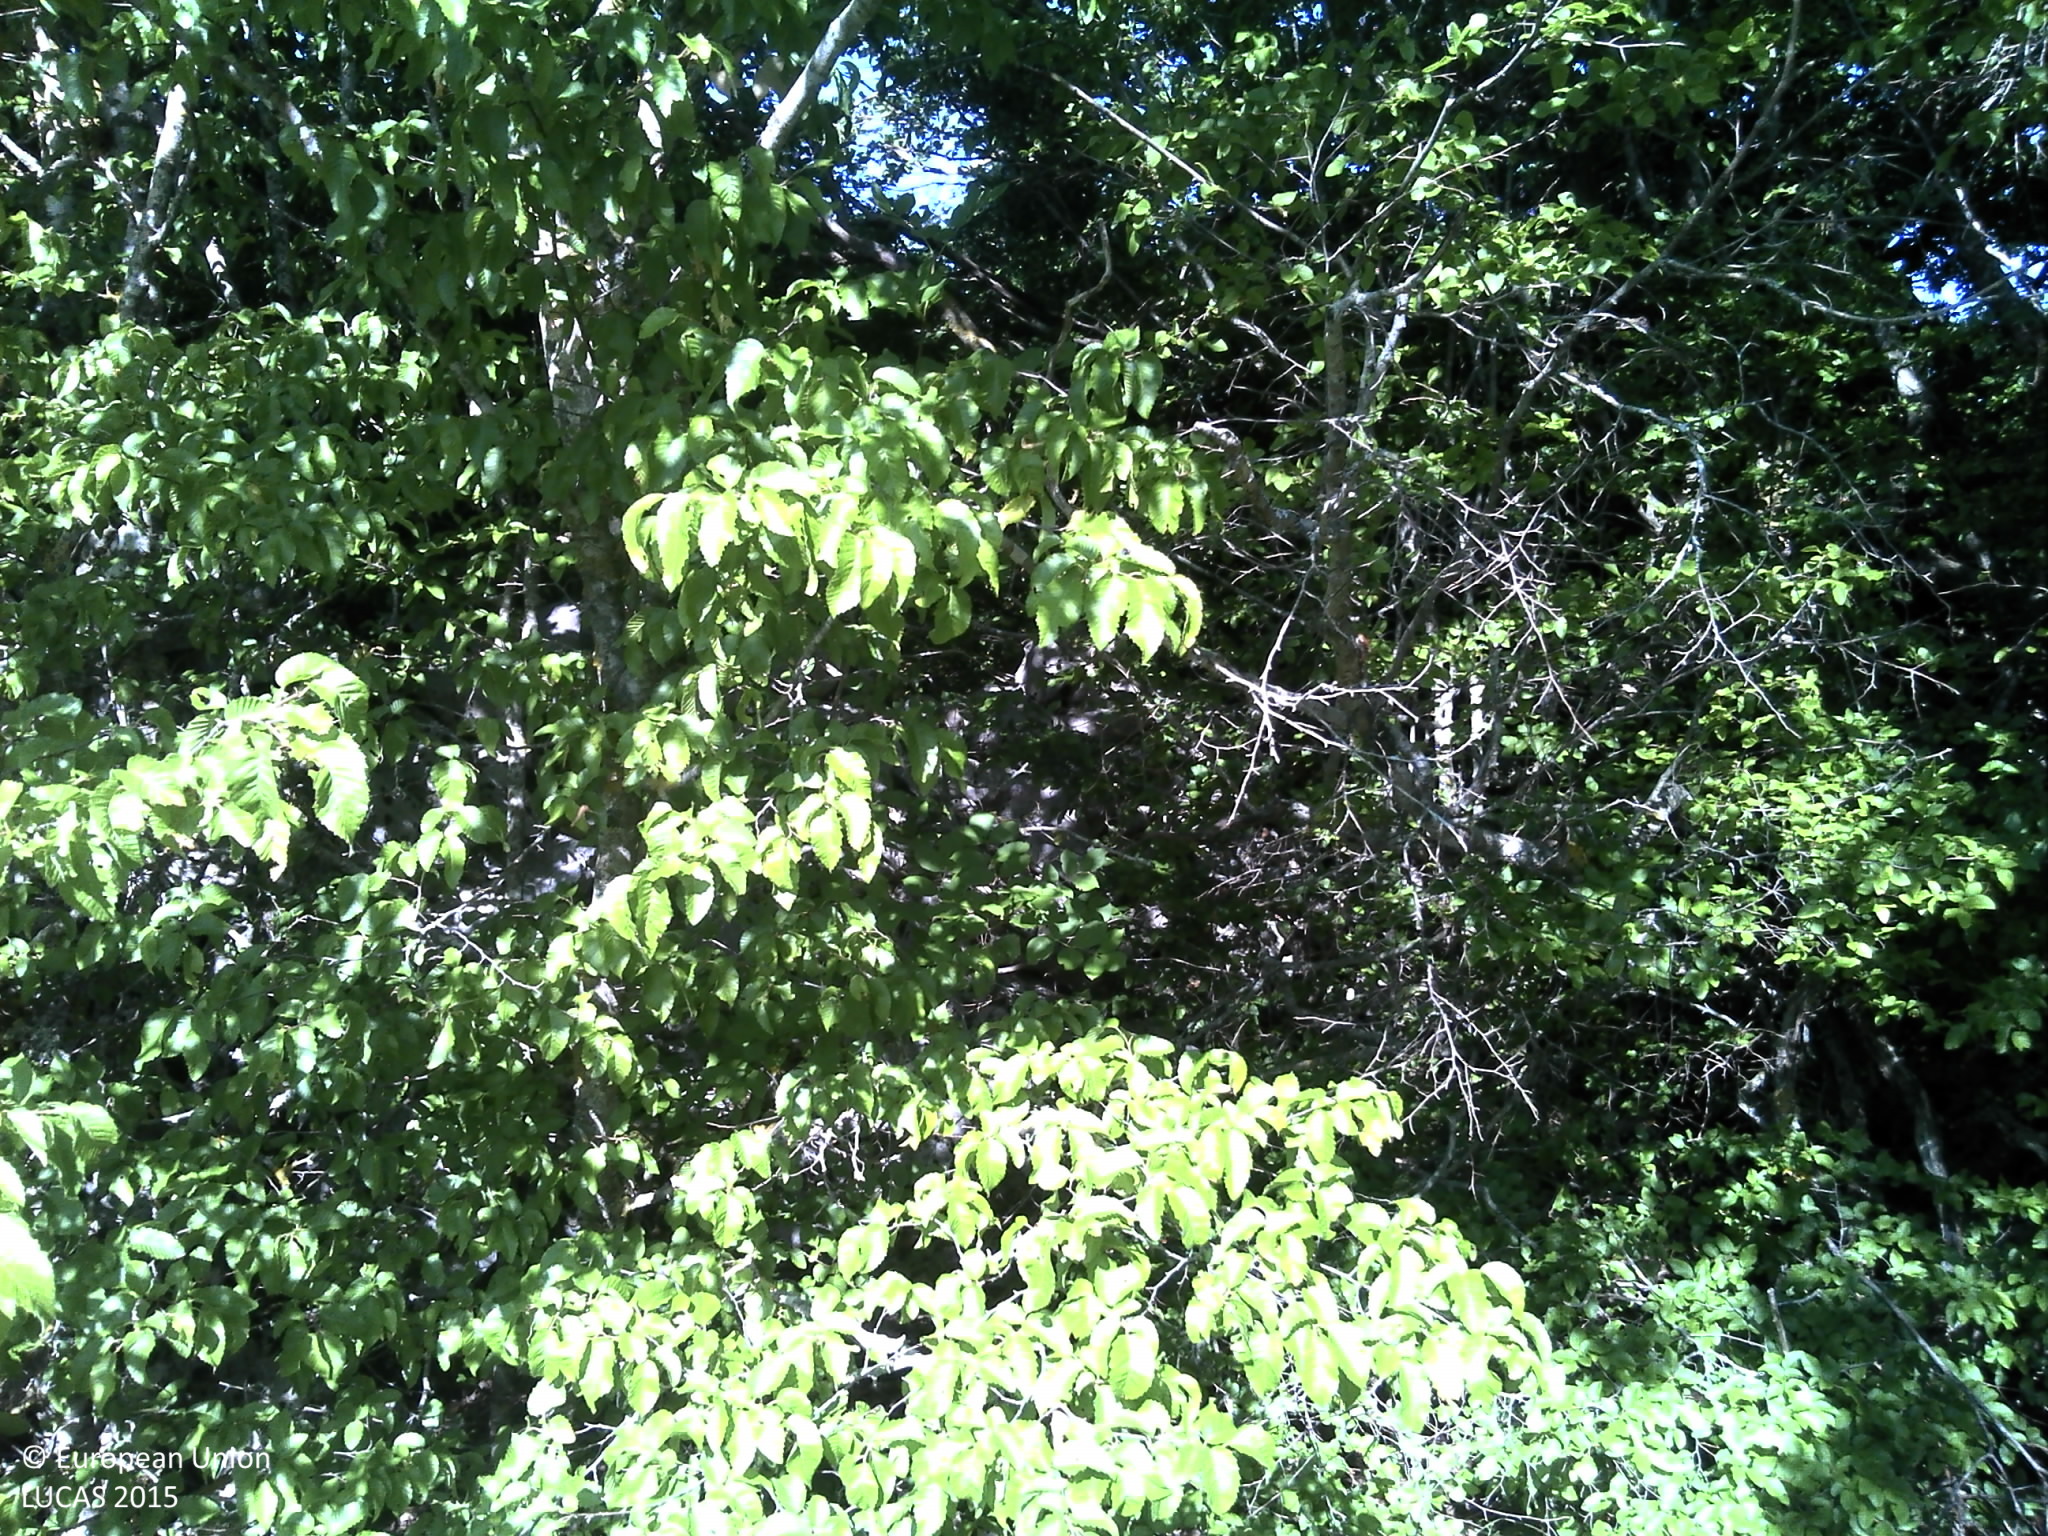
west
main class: Woodland
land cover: Broadleaved woodland
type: thermophilous deciduous forest
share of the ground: 25 - 50 %
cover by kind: shrubs 45 %, broadleaved forest trees 40 %, herbaceous plants 10 %, consolidated bare surface 5 %
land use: Semi-natural and natural areas not in use
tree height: > 5 m
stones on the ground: < 10 %
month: July
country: HR
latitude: 43.5342
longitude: 17.0082
